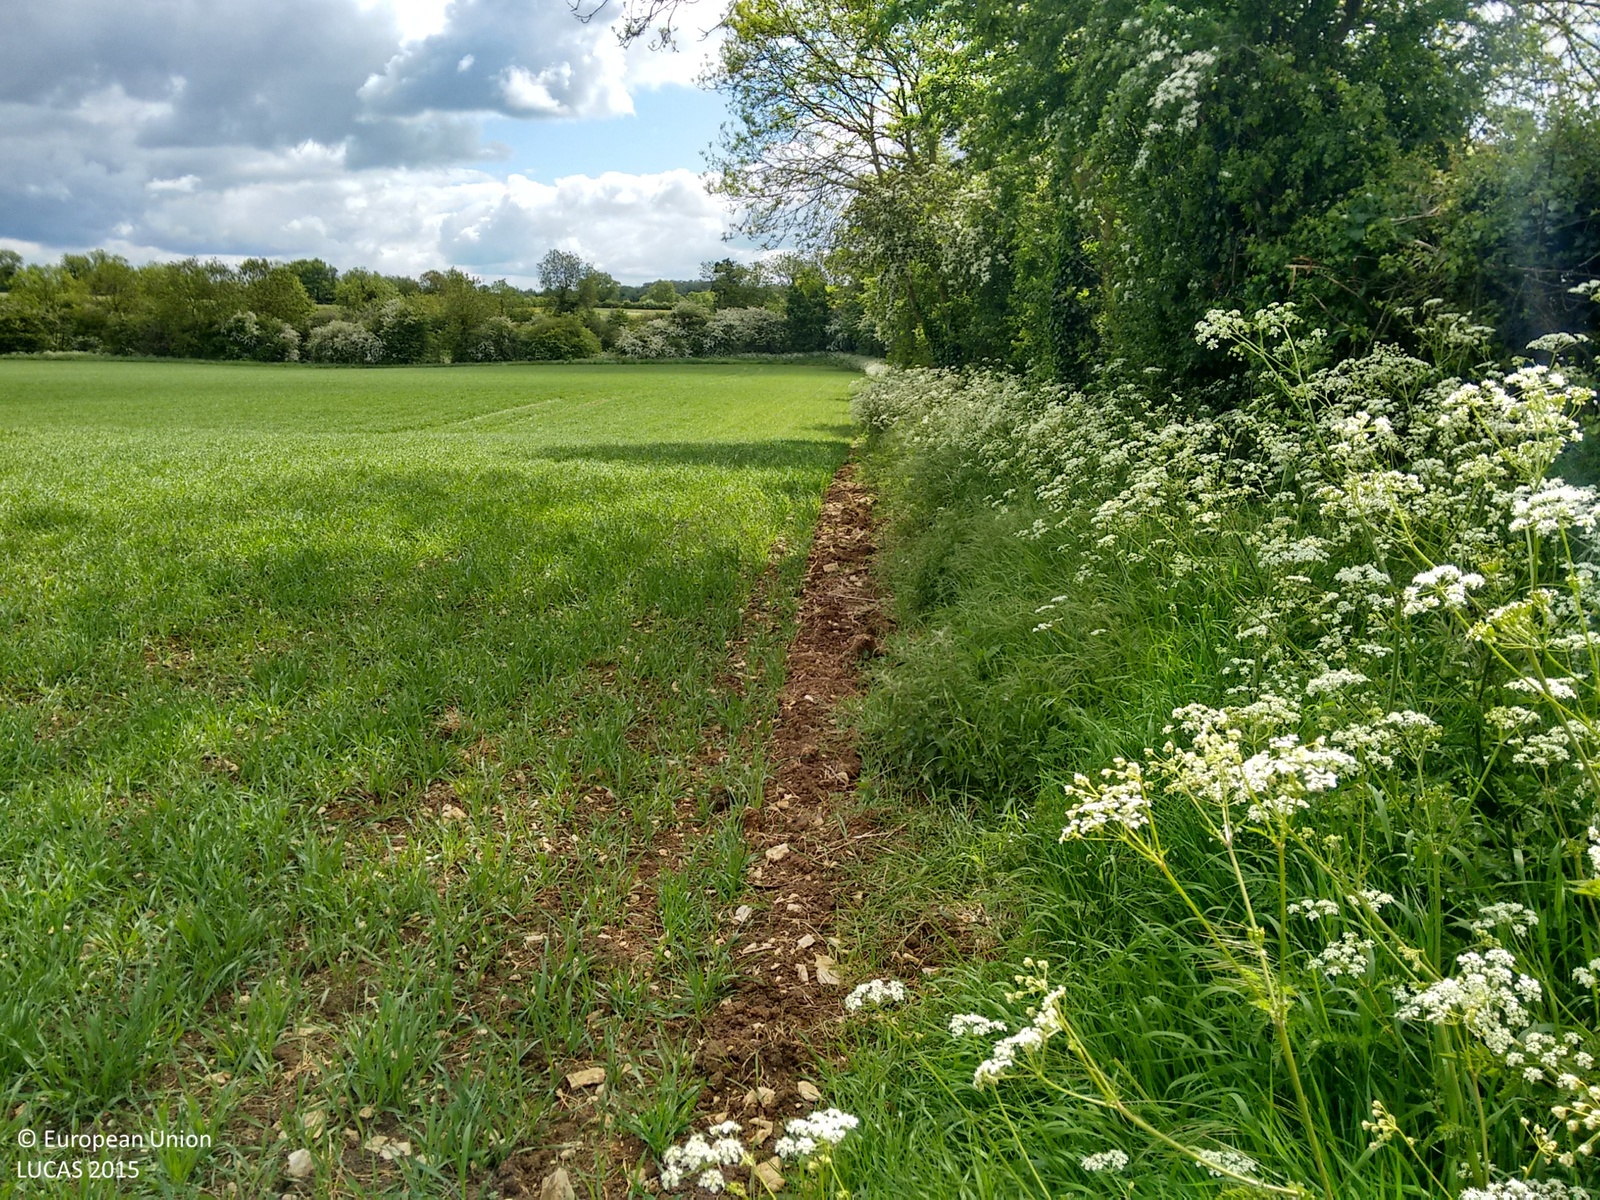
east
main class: Cropland
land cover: Barley
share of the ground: > 75 %
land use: Agriculture (excluding fallow land and kitchen gardens)
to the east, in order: Barley; Grass margins; Grassland with sparse tree/shrub cover; Inland fresh water bodies; Broadleaved woodland; Grassland without tree/shrub cover; Broadleaved woodland; Grassland without tree/shrub cover
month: May
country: GB
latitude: 52.2822
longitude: -1.3803
